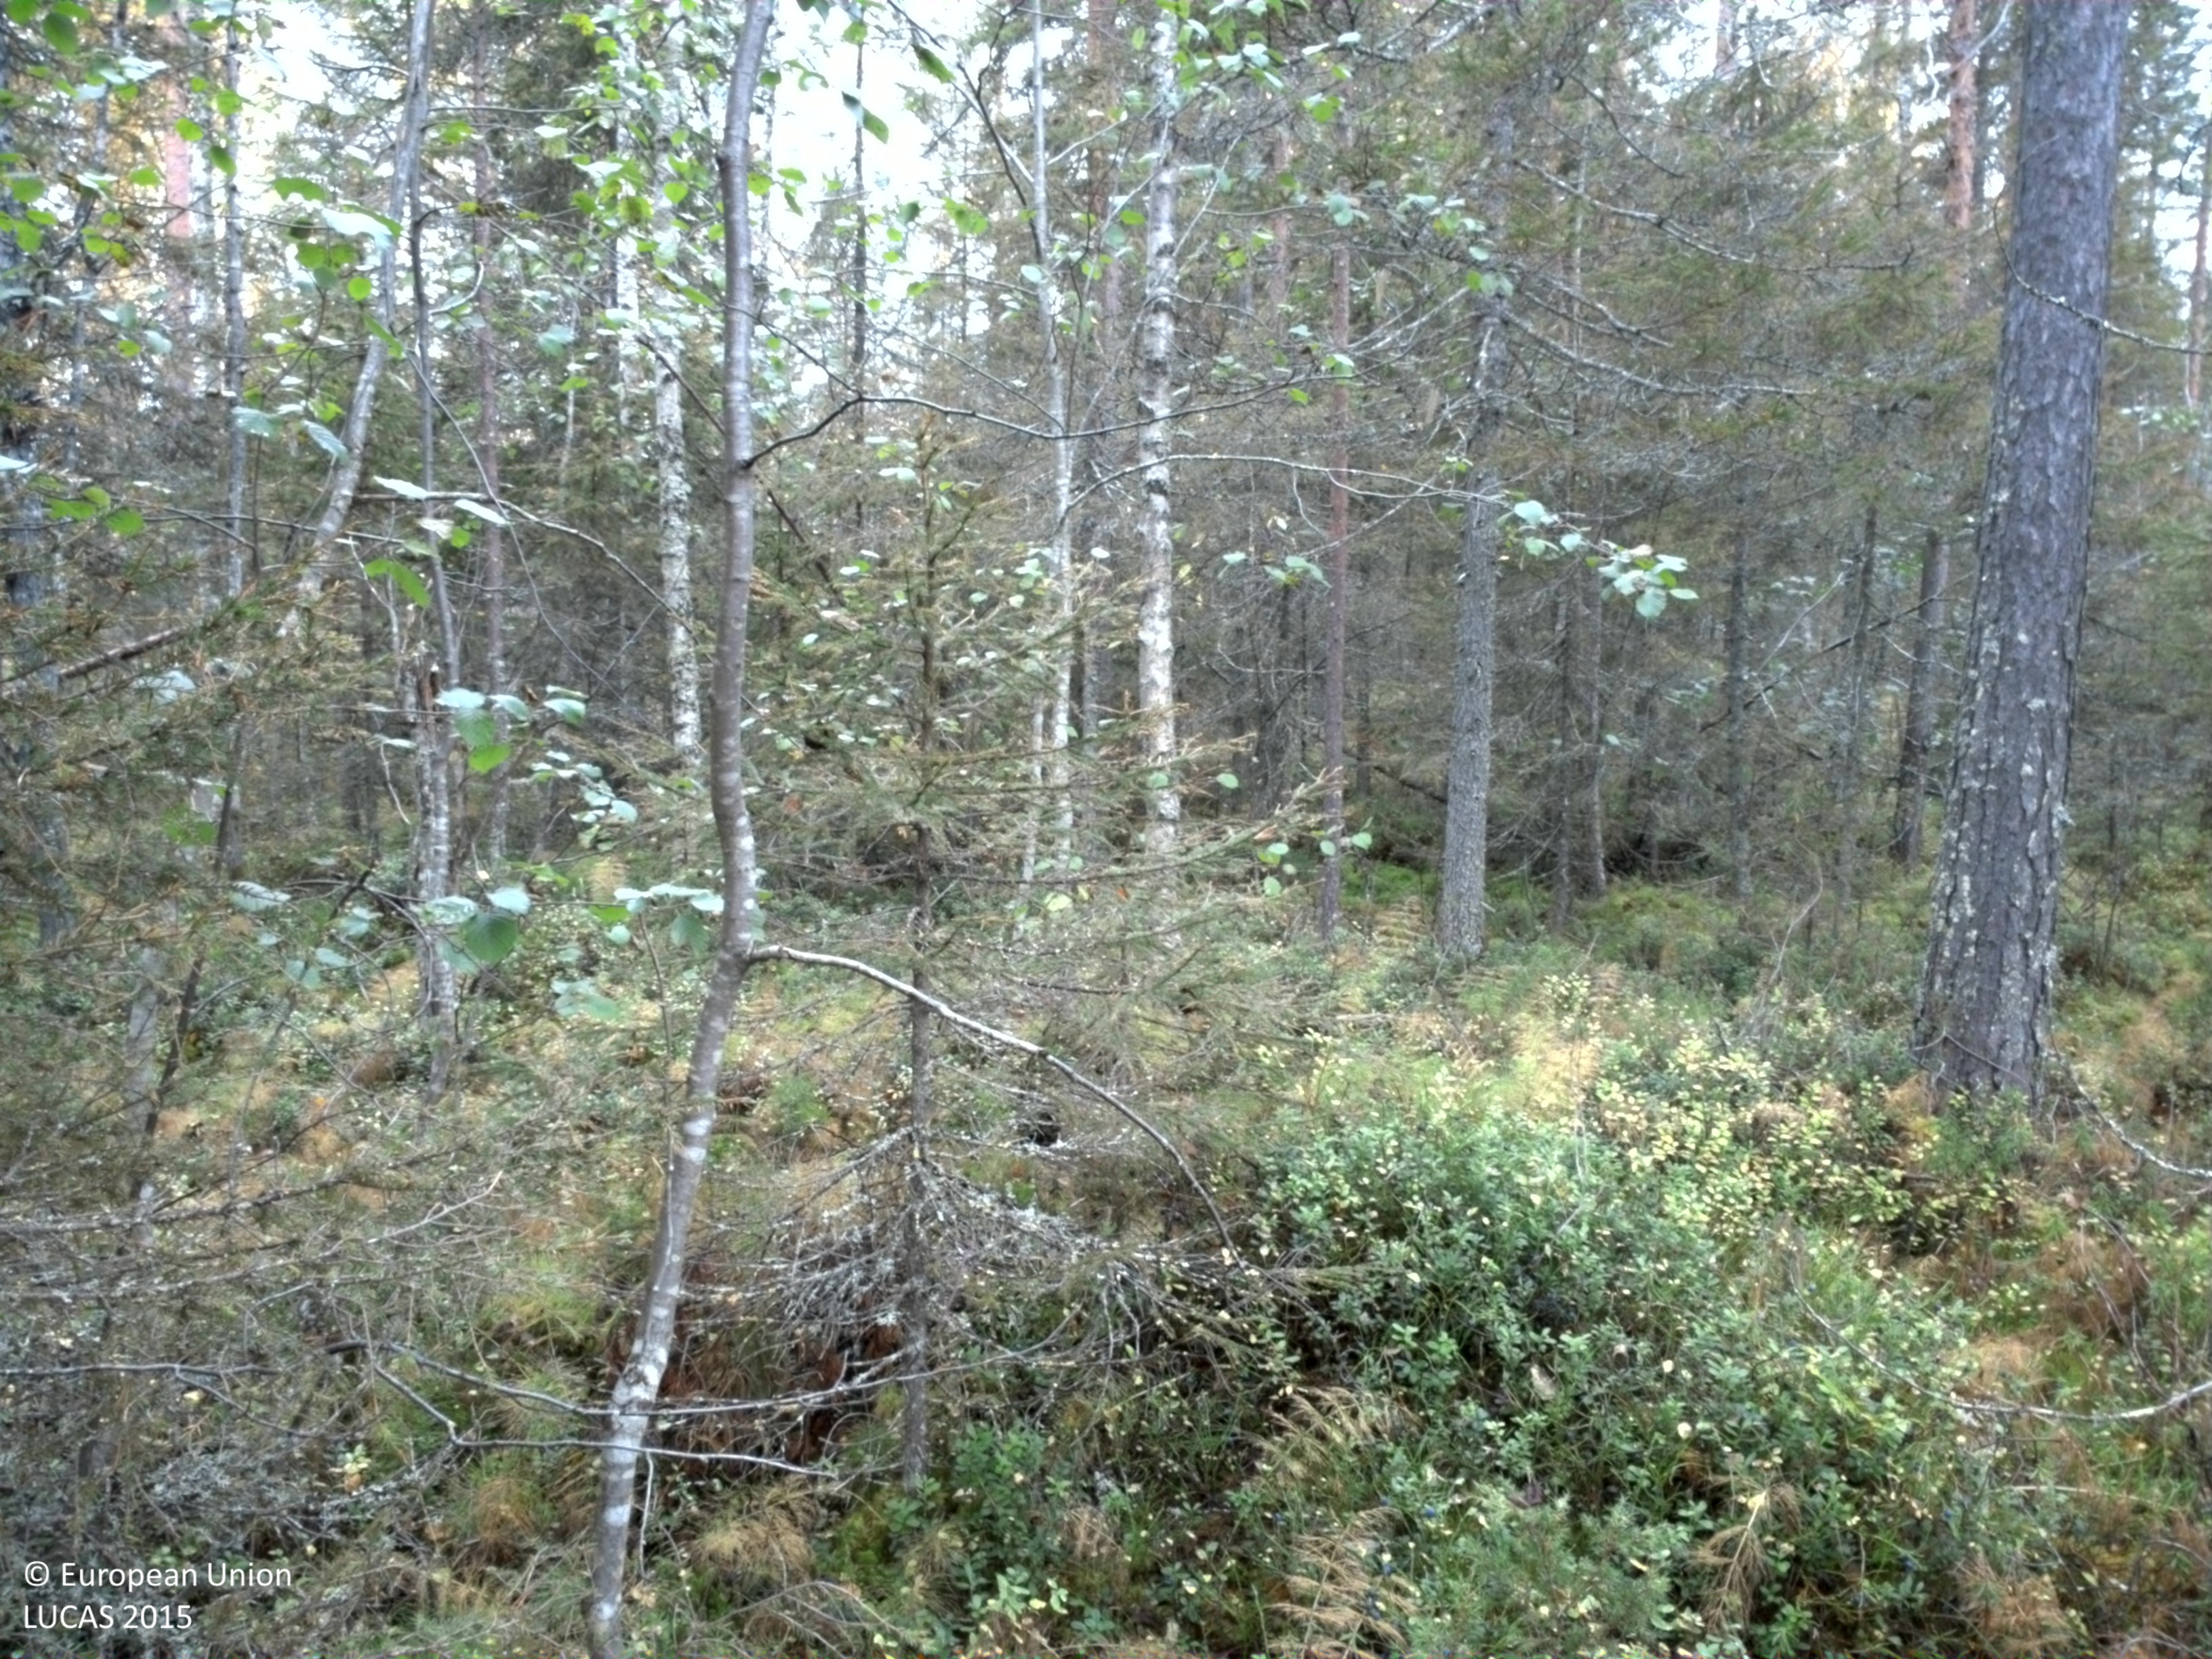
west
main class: Woodland
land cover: Pine dominated coniferous woodland
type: boreal forest
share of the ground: 25 - 50 %
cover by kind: shrubs 60 %, coniferous forest trees 35 %, broadleaved forest trees 5 %
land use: Forestry
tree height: > 5 m
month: September
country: SE
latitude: 65.7405
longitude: 21.9505
